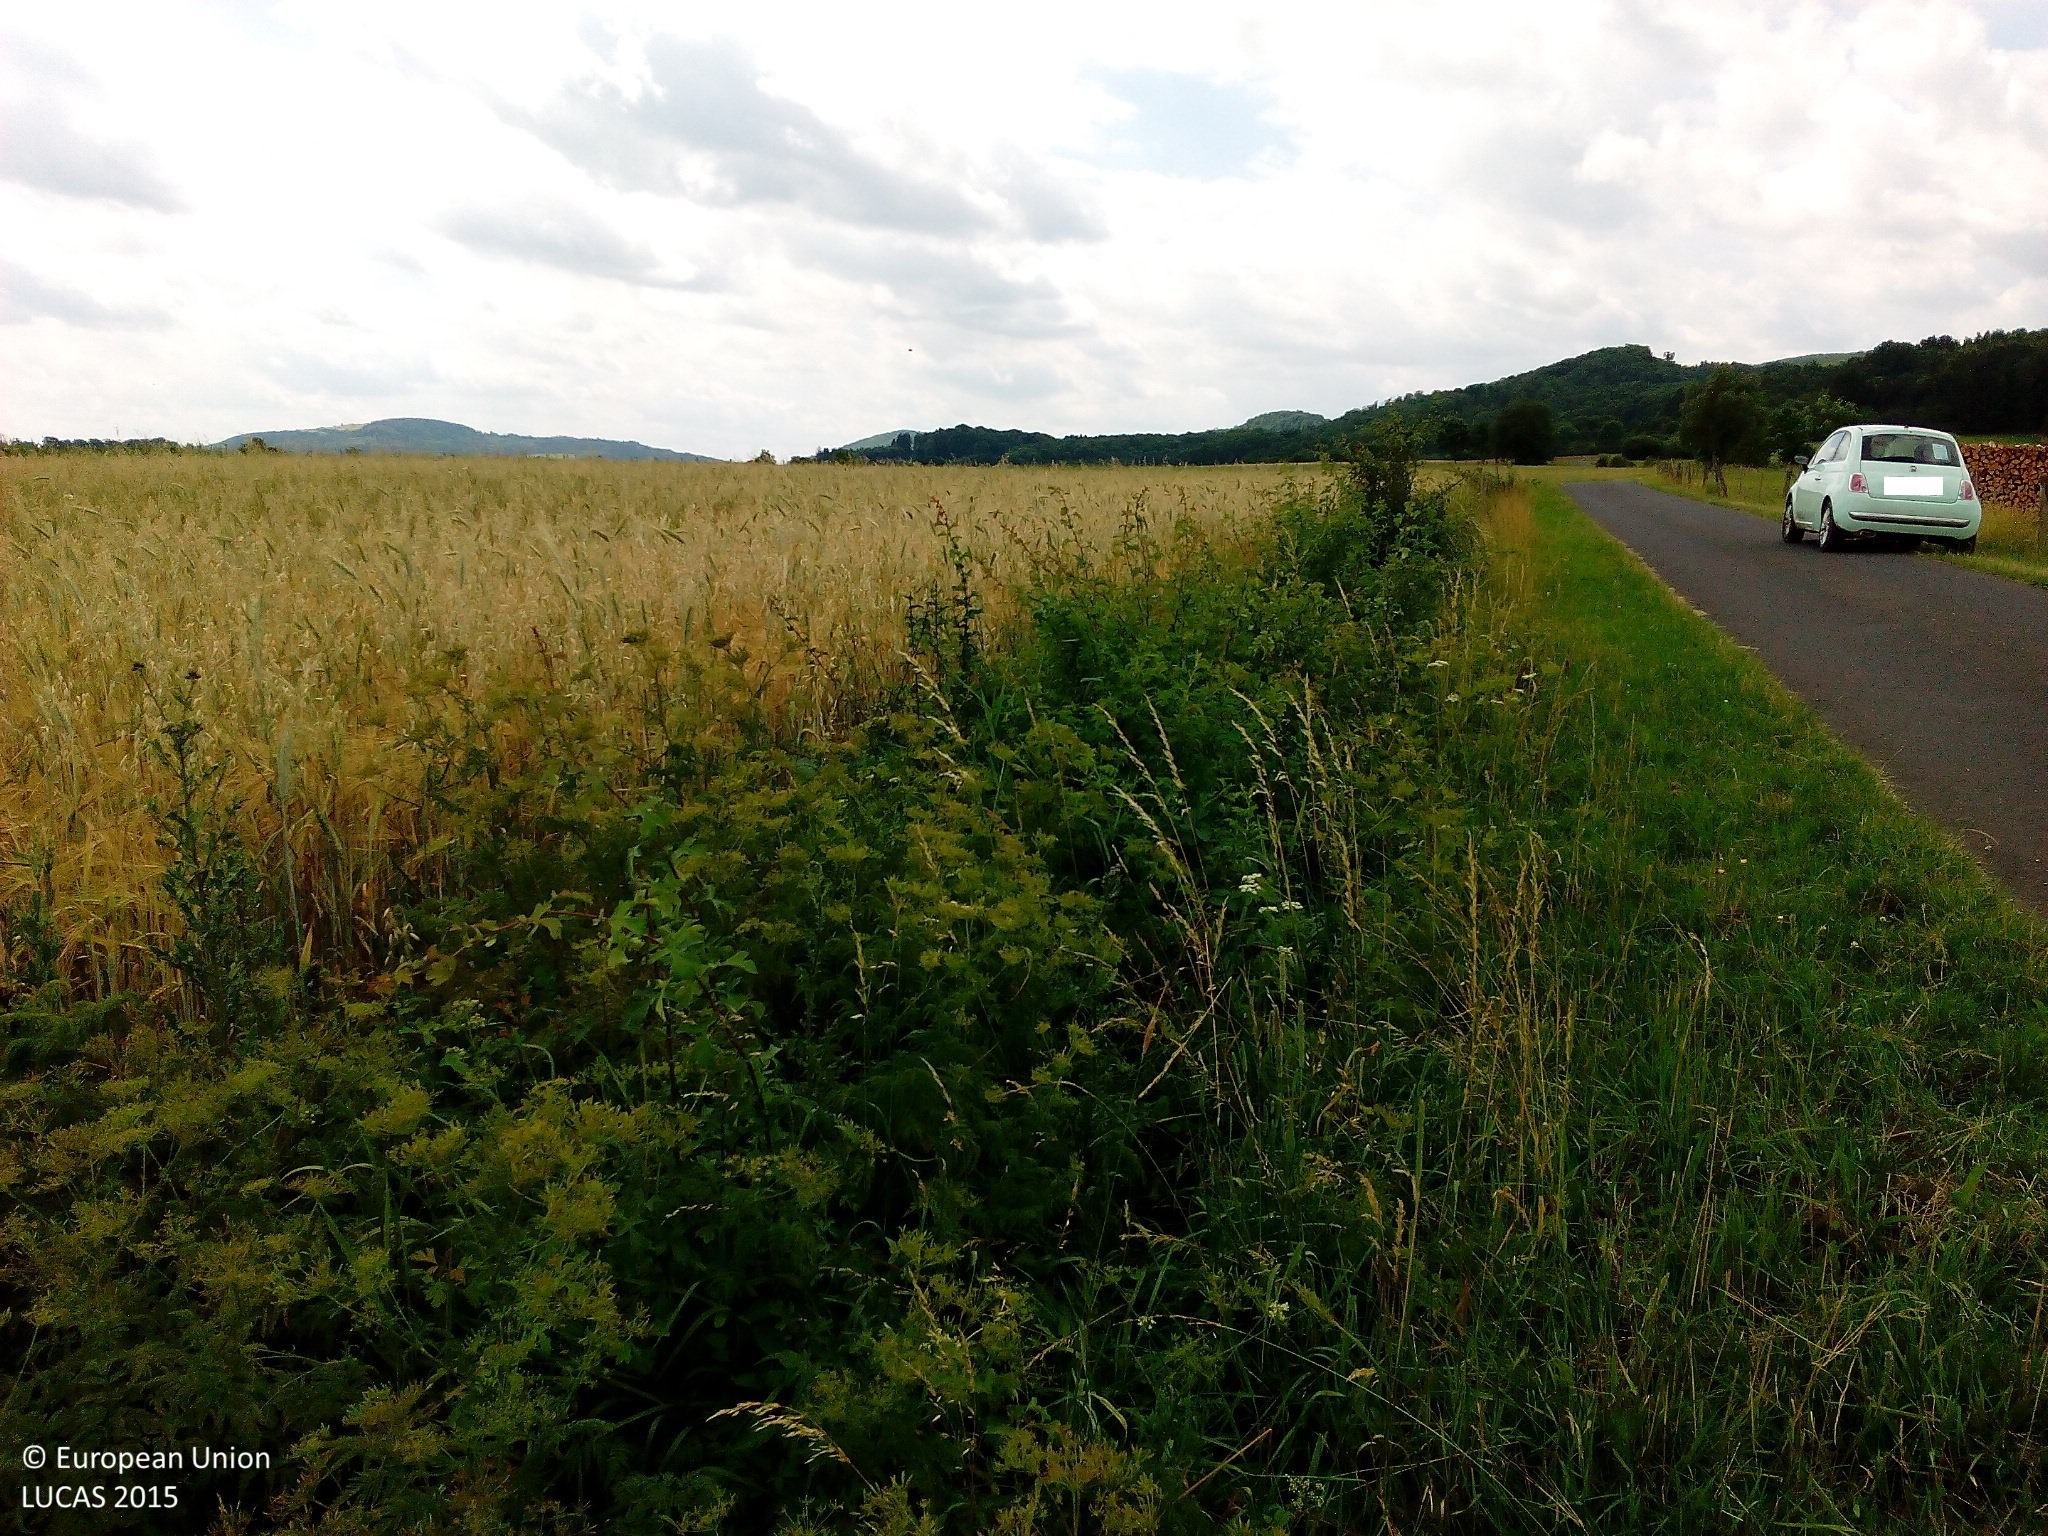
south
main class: Cropland
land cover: Mixed cereals for fodder
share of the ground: > 75 %
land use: Agriculture (excluding fallow land and kitchen gardens)
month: July
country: DE
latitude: 50.6876
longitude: 9.9009
